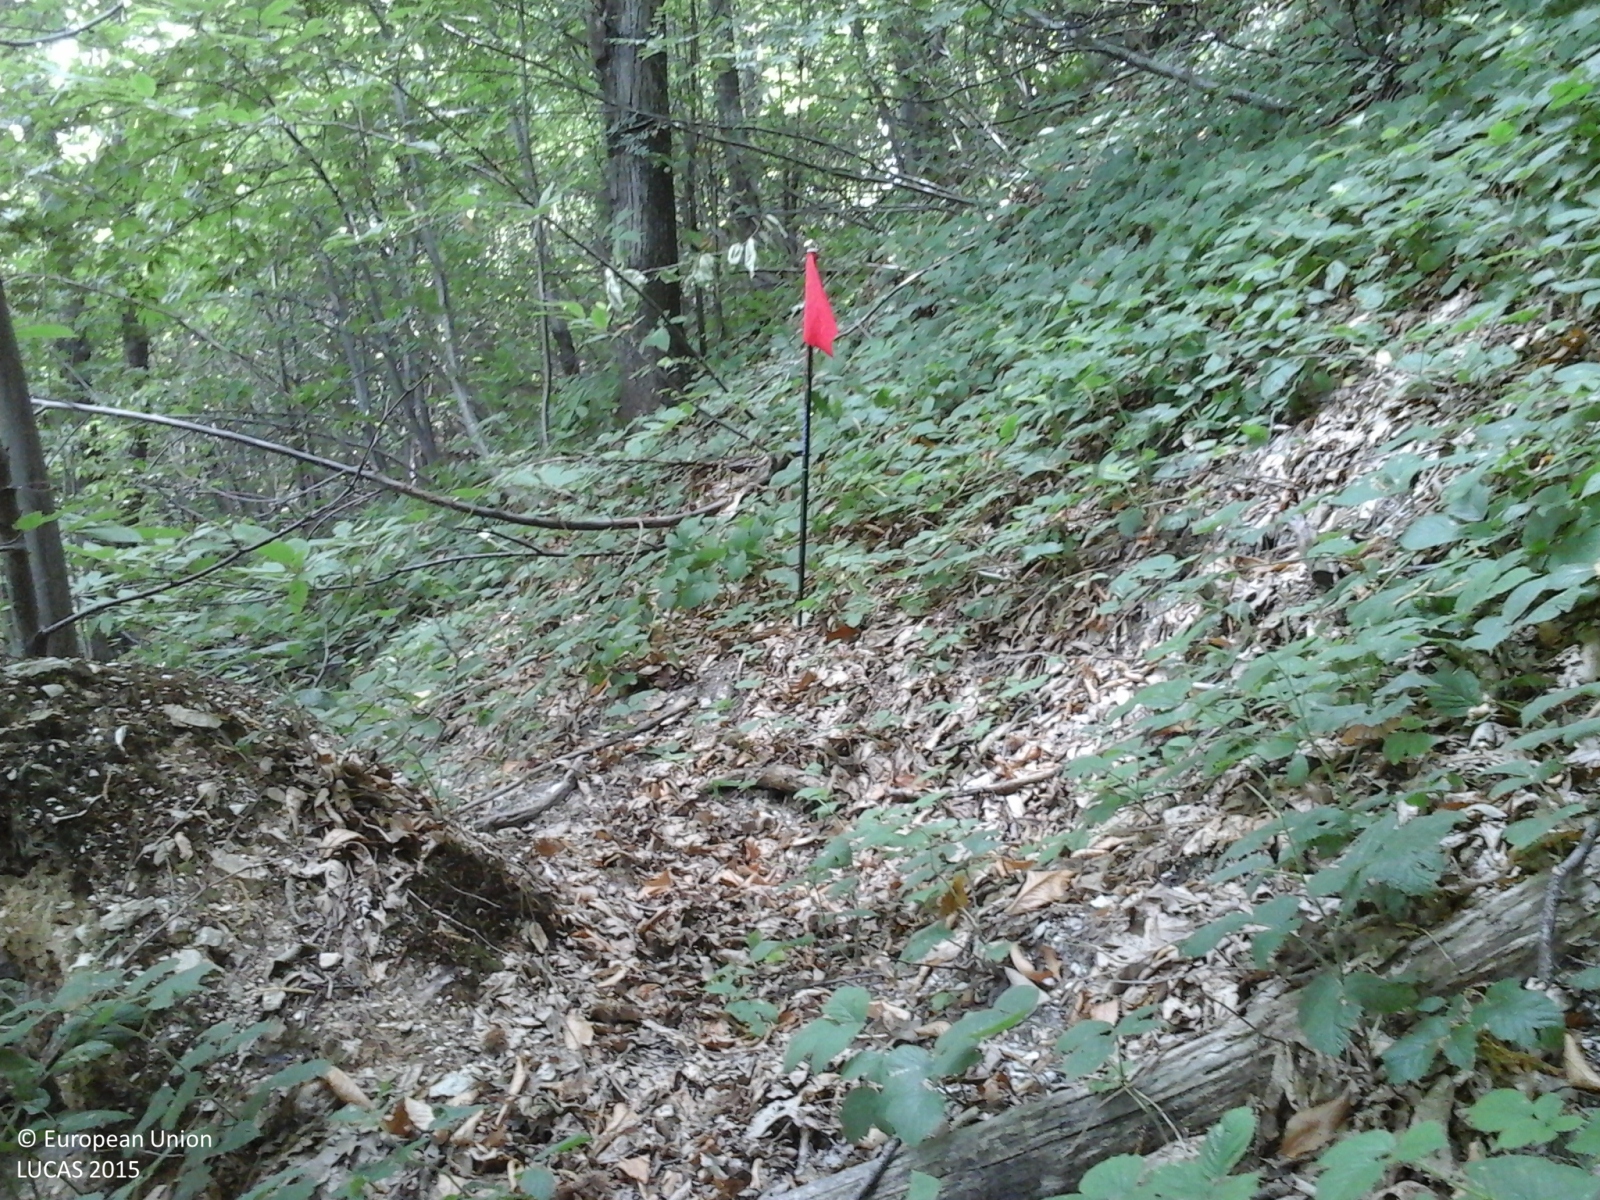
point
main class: Woodland
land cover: Broadleaved woodland
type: mesophytic deciduous forest
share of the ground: > 75 %
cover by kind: broadleaved forest trees 95 %, shrubs 5 %
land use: Forestry
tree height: > 5 m
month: July
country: IT
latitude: 44.3033
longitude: 7.5359
